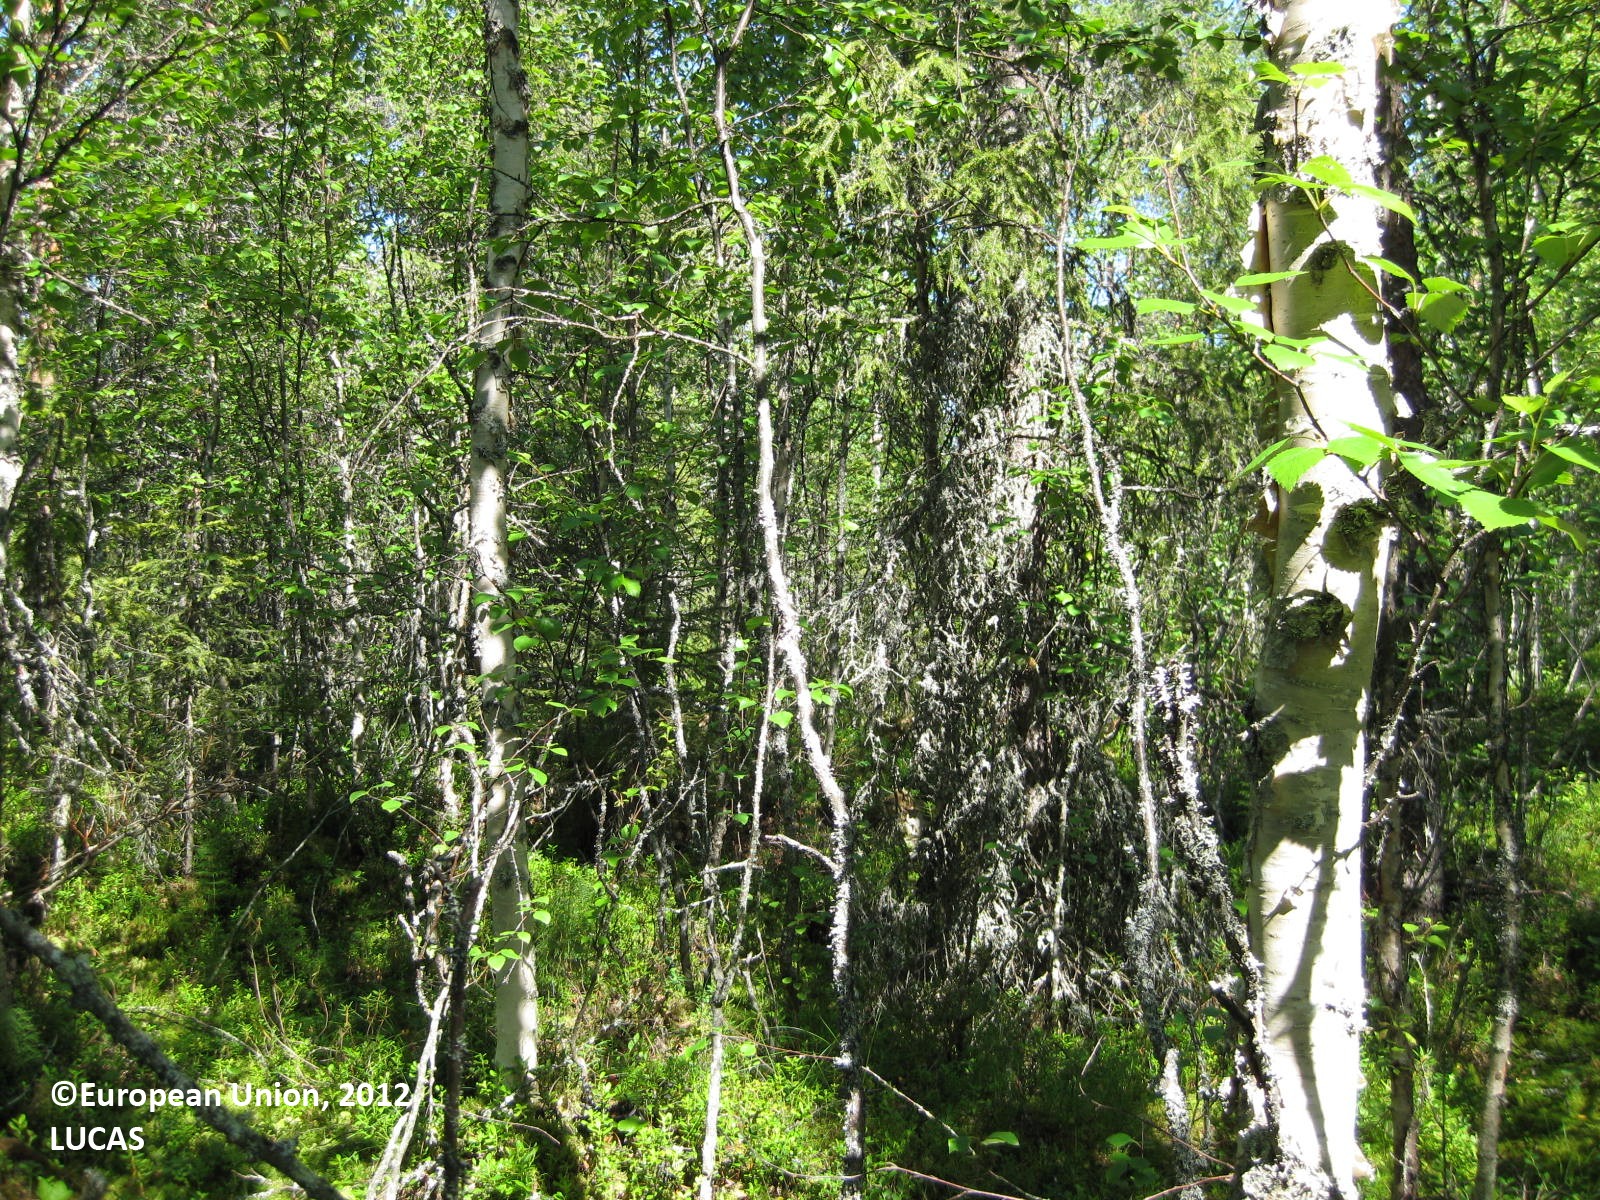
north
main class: Woodland
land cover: Pine dominated mixed woodland
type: boreal forest
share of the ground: > 75 %
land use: Forestry
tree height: > 5 m
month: July
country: FI
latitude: 65.6121
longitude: 28.5000
